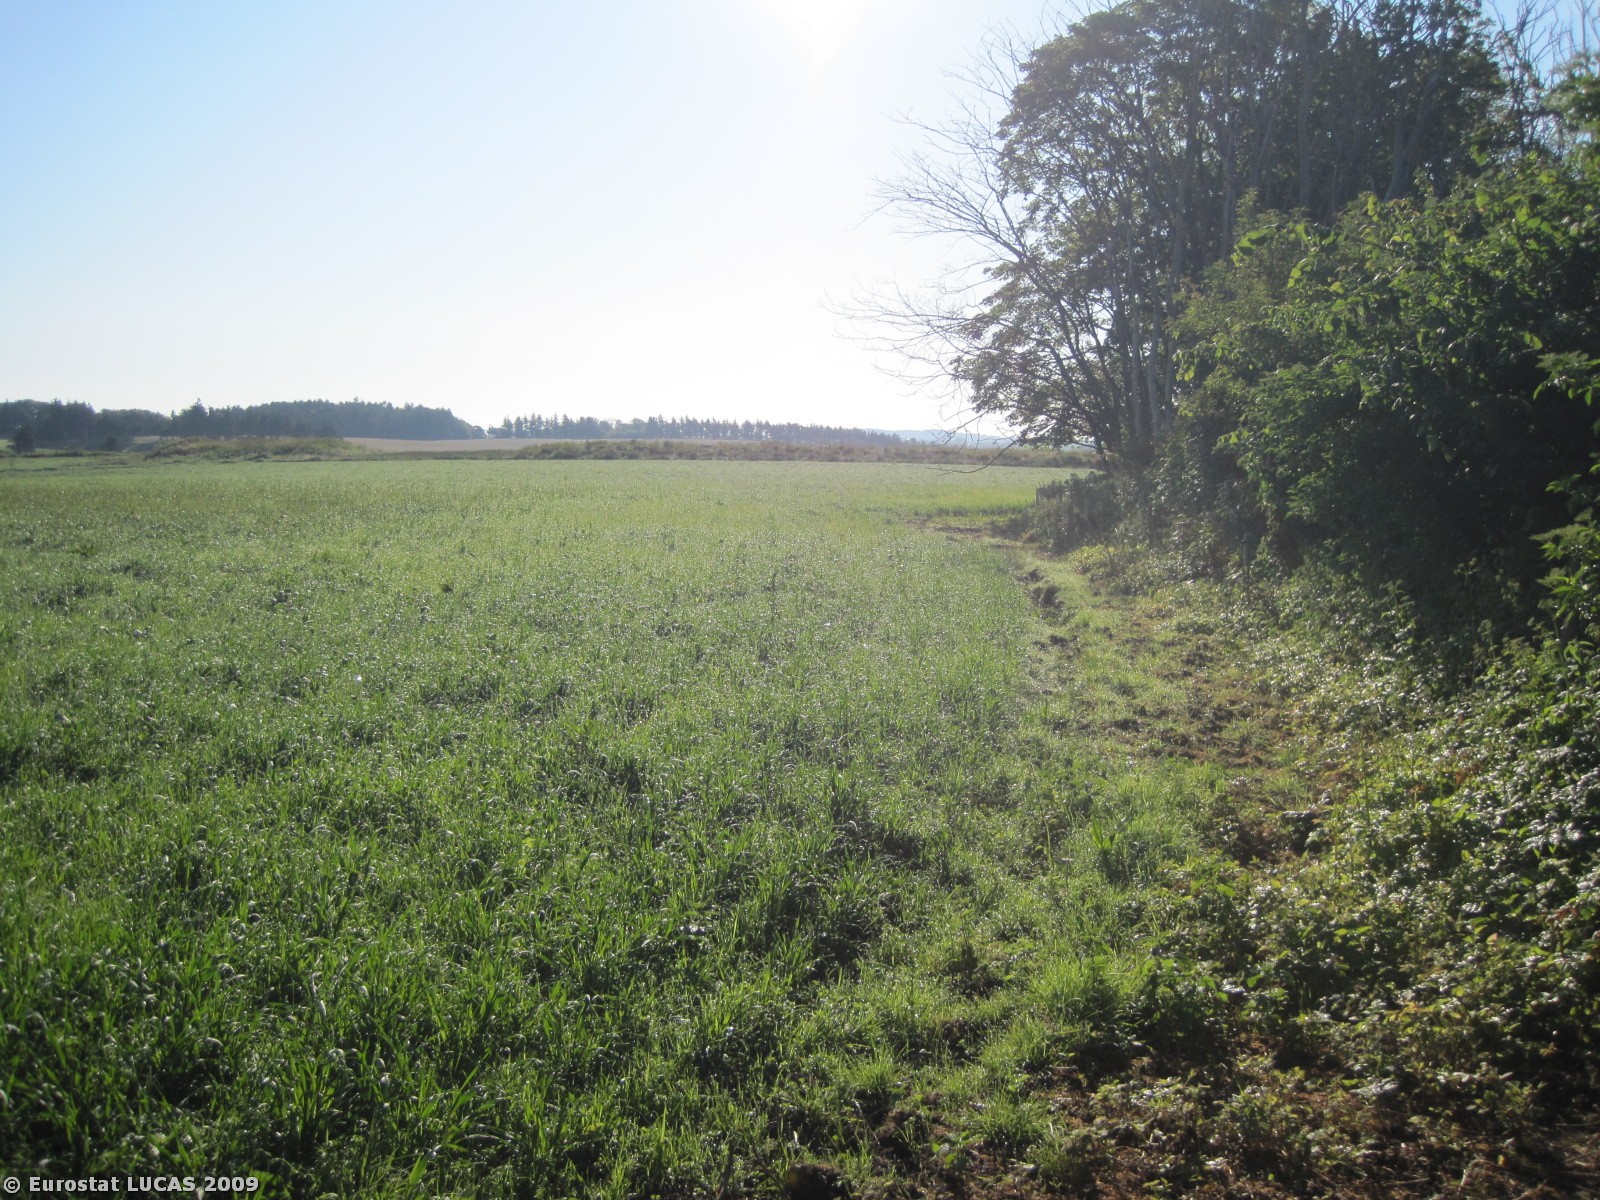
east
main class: Woodland
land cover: Broadleaved woodland
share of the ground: > 75 %
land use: Residential
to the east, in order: Broadleaved woodland; Grassland without tree/shrub cover; Broadleaved woodland; Grassland without tree/shrub cover; Barley; Grassland without tree/shrub cover; Temporary grasslands; Grassland without tree/shrub cover; Tracks; Grassland without tree/shrub cover; Temporary grasslands
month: June
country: DK
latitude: 57.4821
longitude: 9.8834
